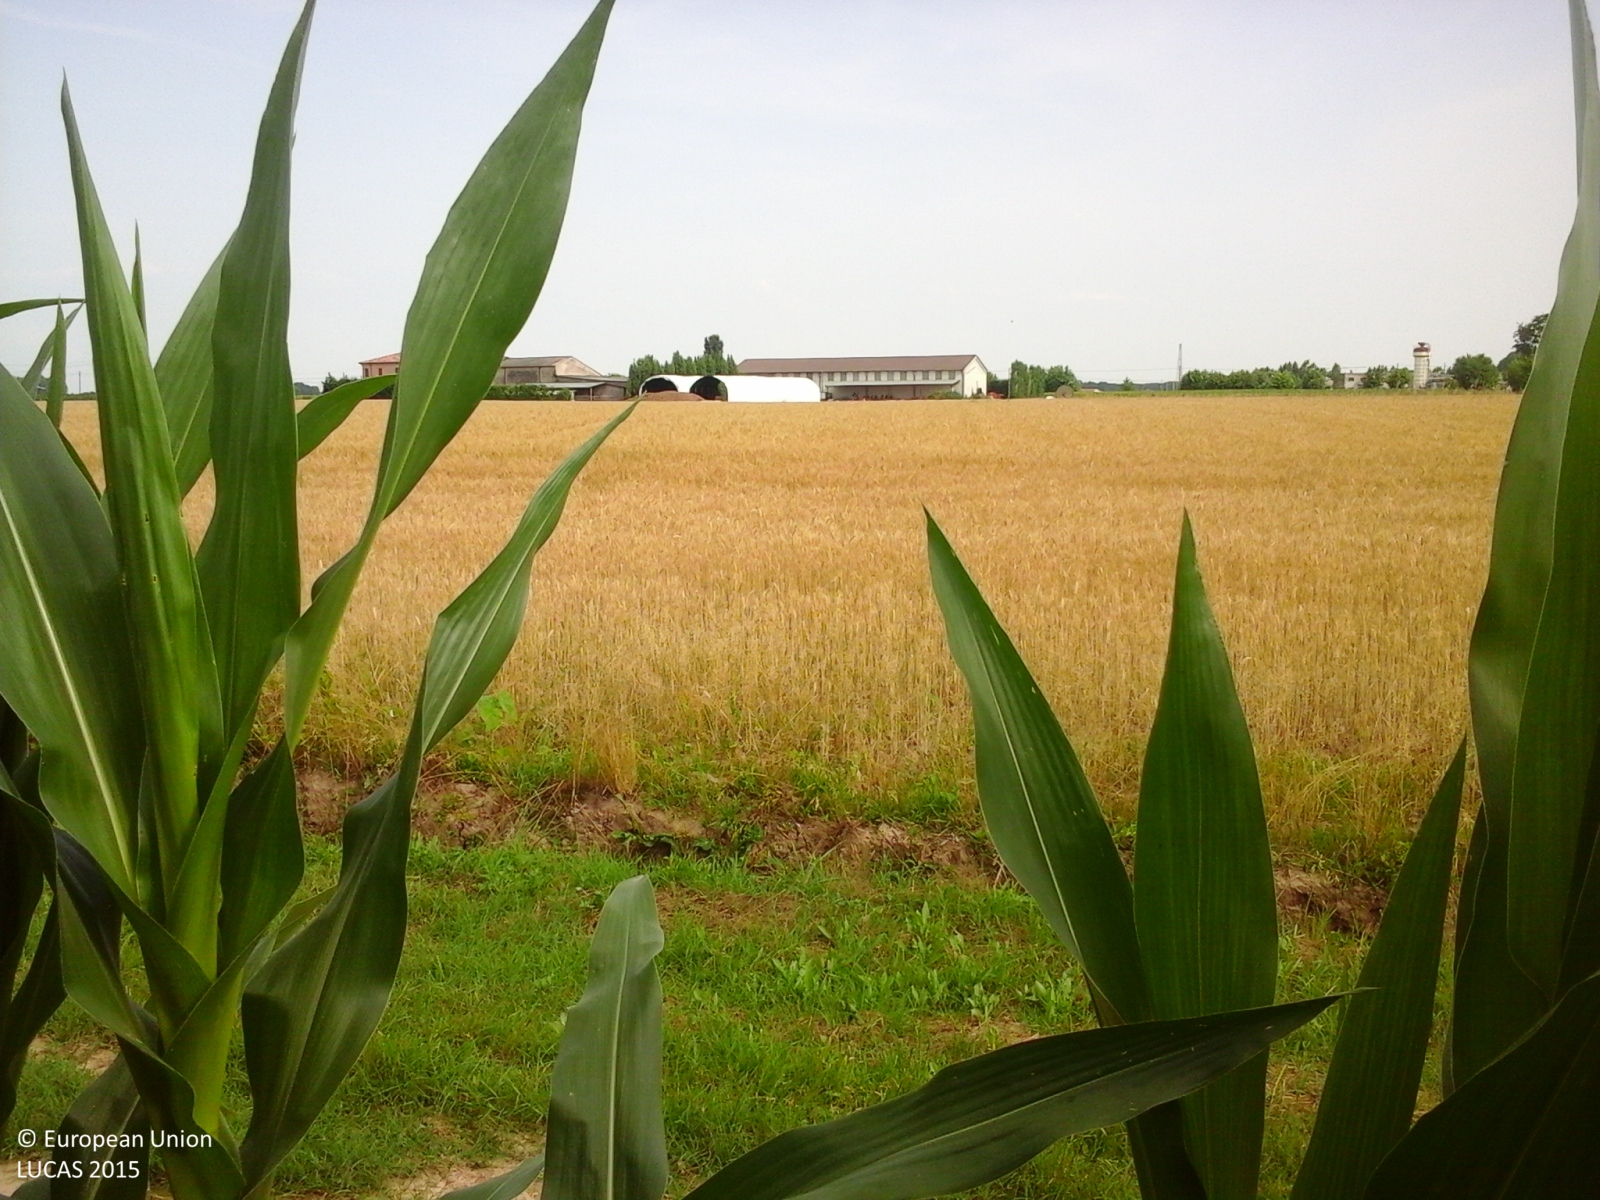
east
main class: Cropland
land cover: Maize
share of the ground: > 75 %
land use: Agriculture (excluding fallow land and kitchen gardens)
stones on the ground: < 10 %
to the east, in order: Maize; Grassland without tree/shrub cover; Ditches and canals; Common wheat; Artificial constructions in urban areas; Ditches and canals; Electric lines; Paved roads, cycling and walking lanes; Ditches and canals; Maize
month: June
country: IT
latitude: 45.2274
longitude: 11.1823
